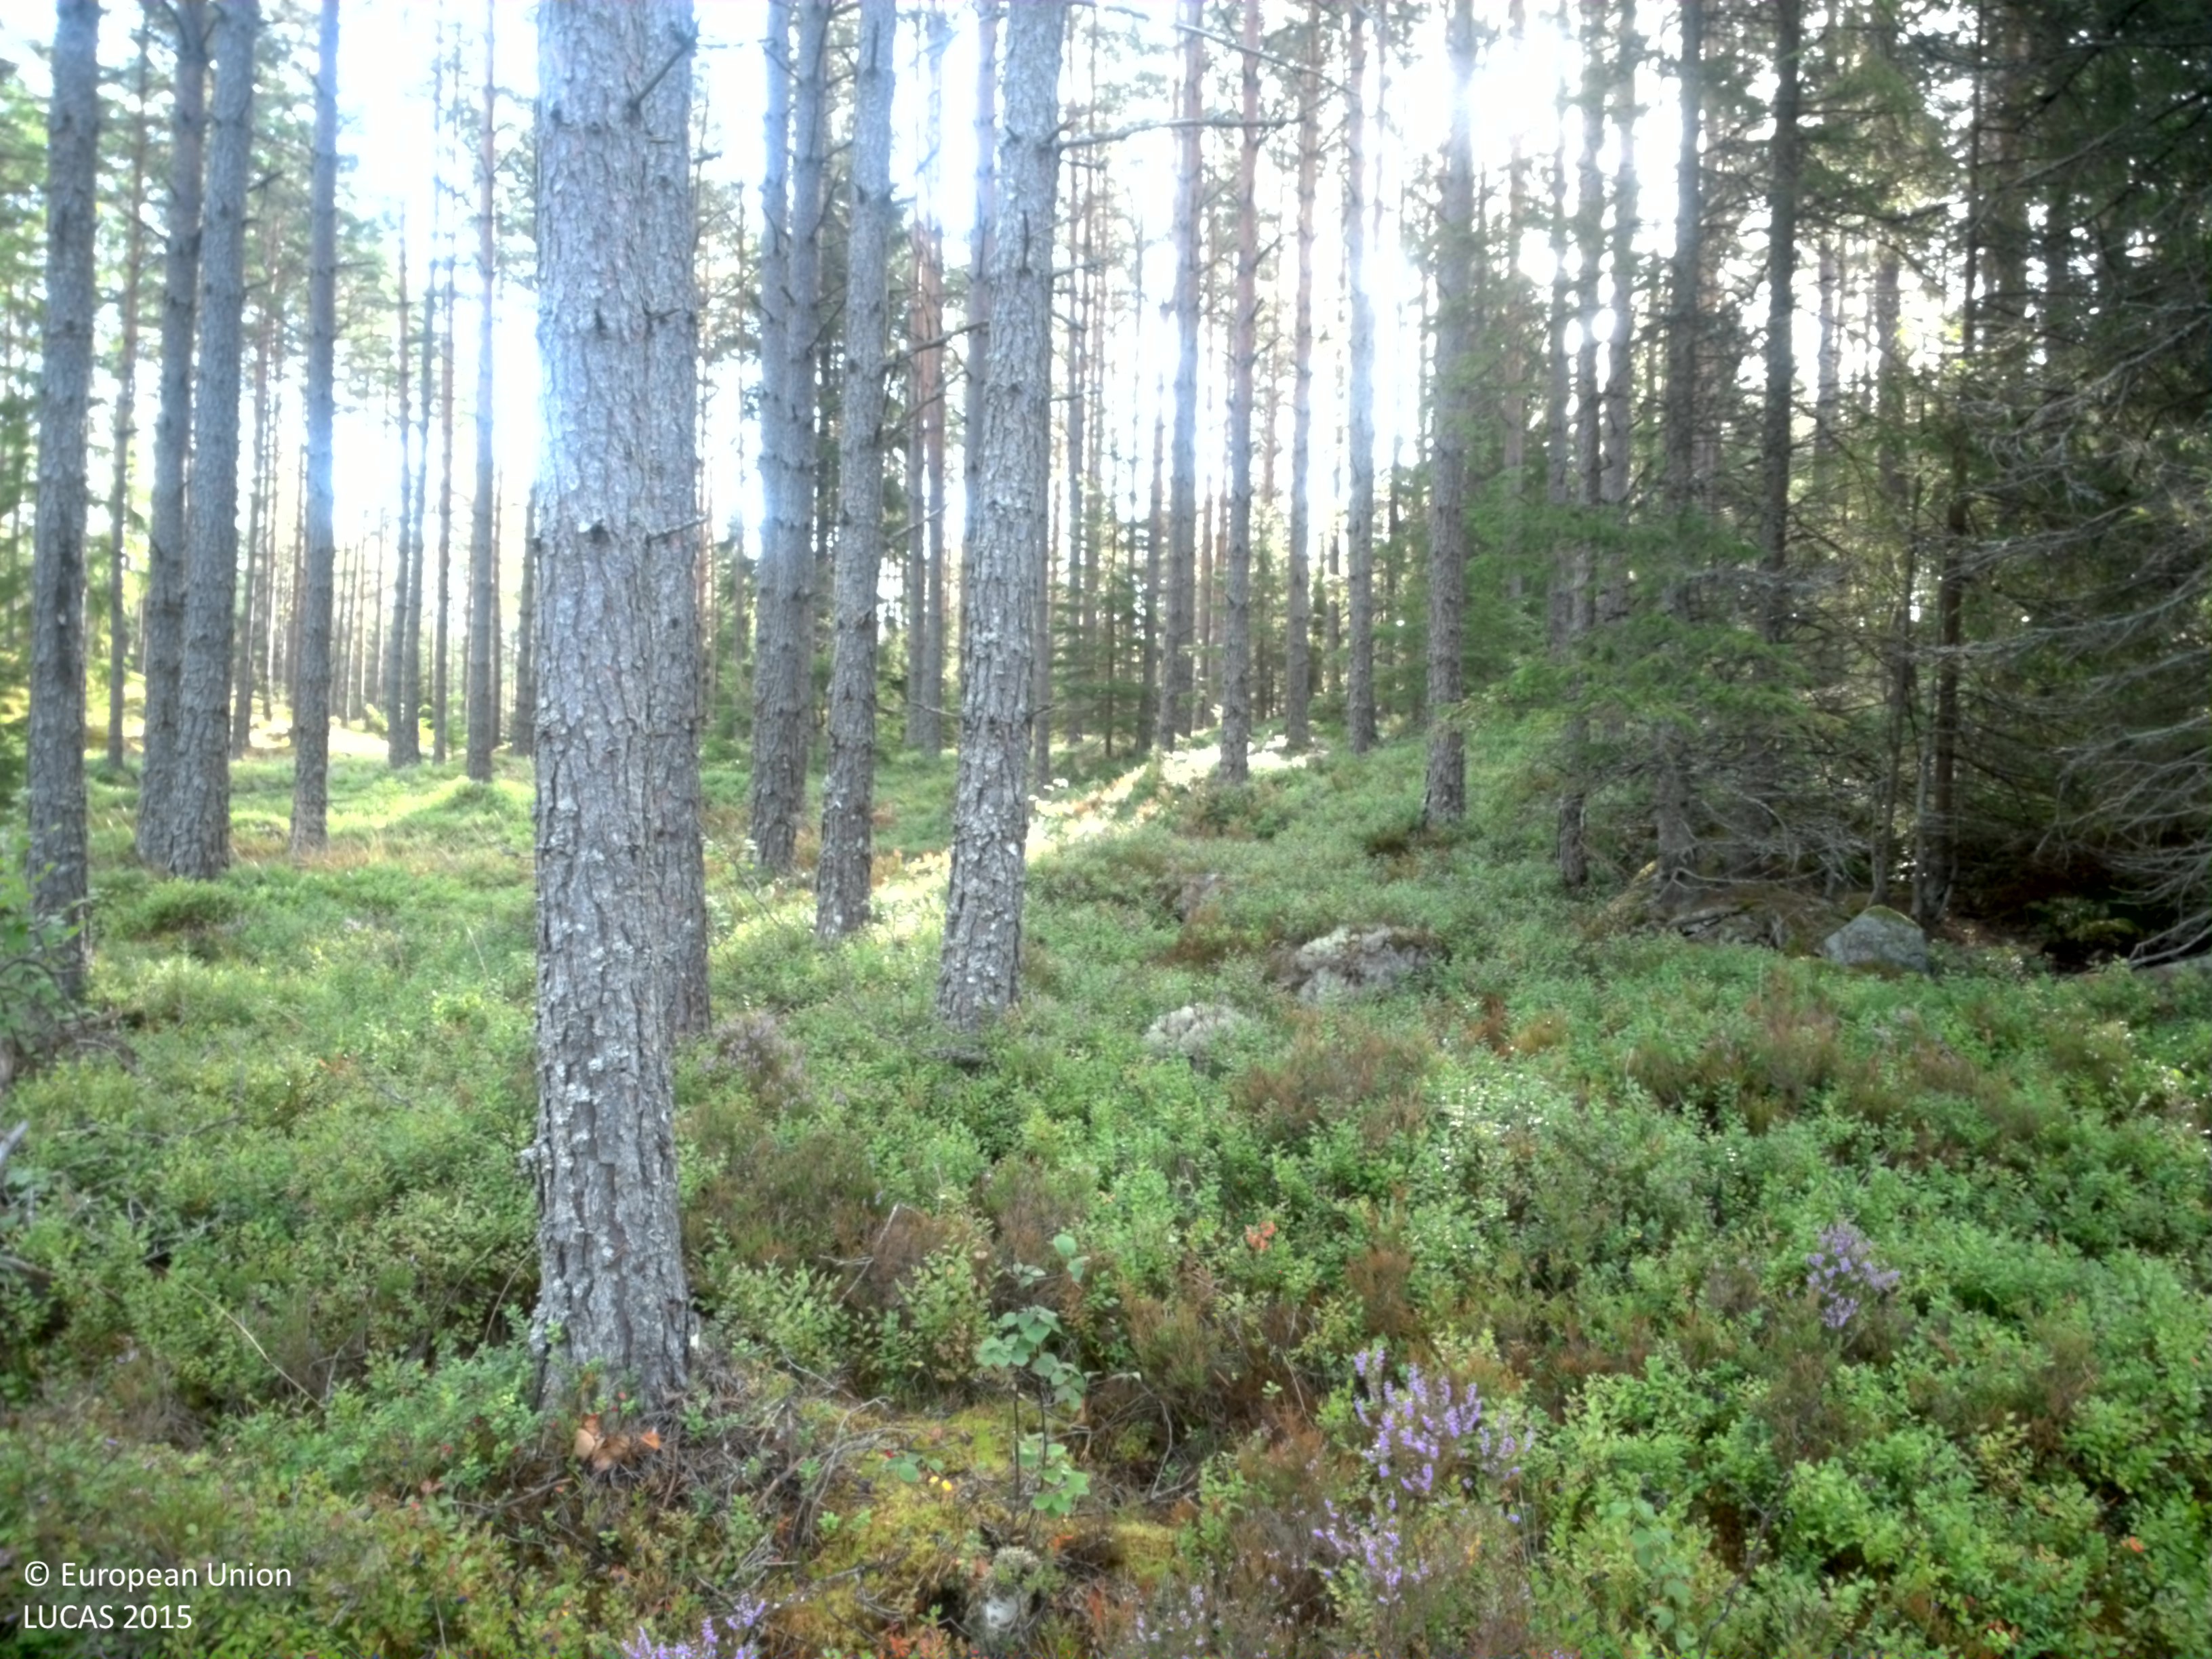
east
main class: Woodland
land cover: Pine dominated coniferous woodland
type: boreal forest
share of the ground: 25 - 50 %
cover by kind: coniferous forest trees 35 %, shrubs 30 %, lichens and mosses 30 %, broadleaved forest trees 5 %
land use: Forestry
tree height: > 5 m
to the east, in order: Pine dominated coniferous woodland; Spruce dominated mixed woodland; Pine dominated coniferous woodland; Tracks; Pine dominated coniferous woodland; Tracks; Pine dominated coniferous woodland; Tracks; Pine dominated coniferous woodland
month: August
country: SE
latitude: 57.7834
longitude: 13.9472
